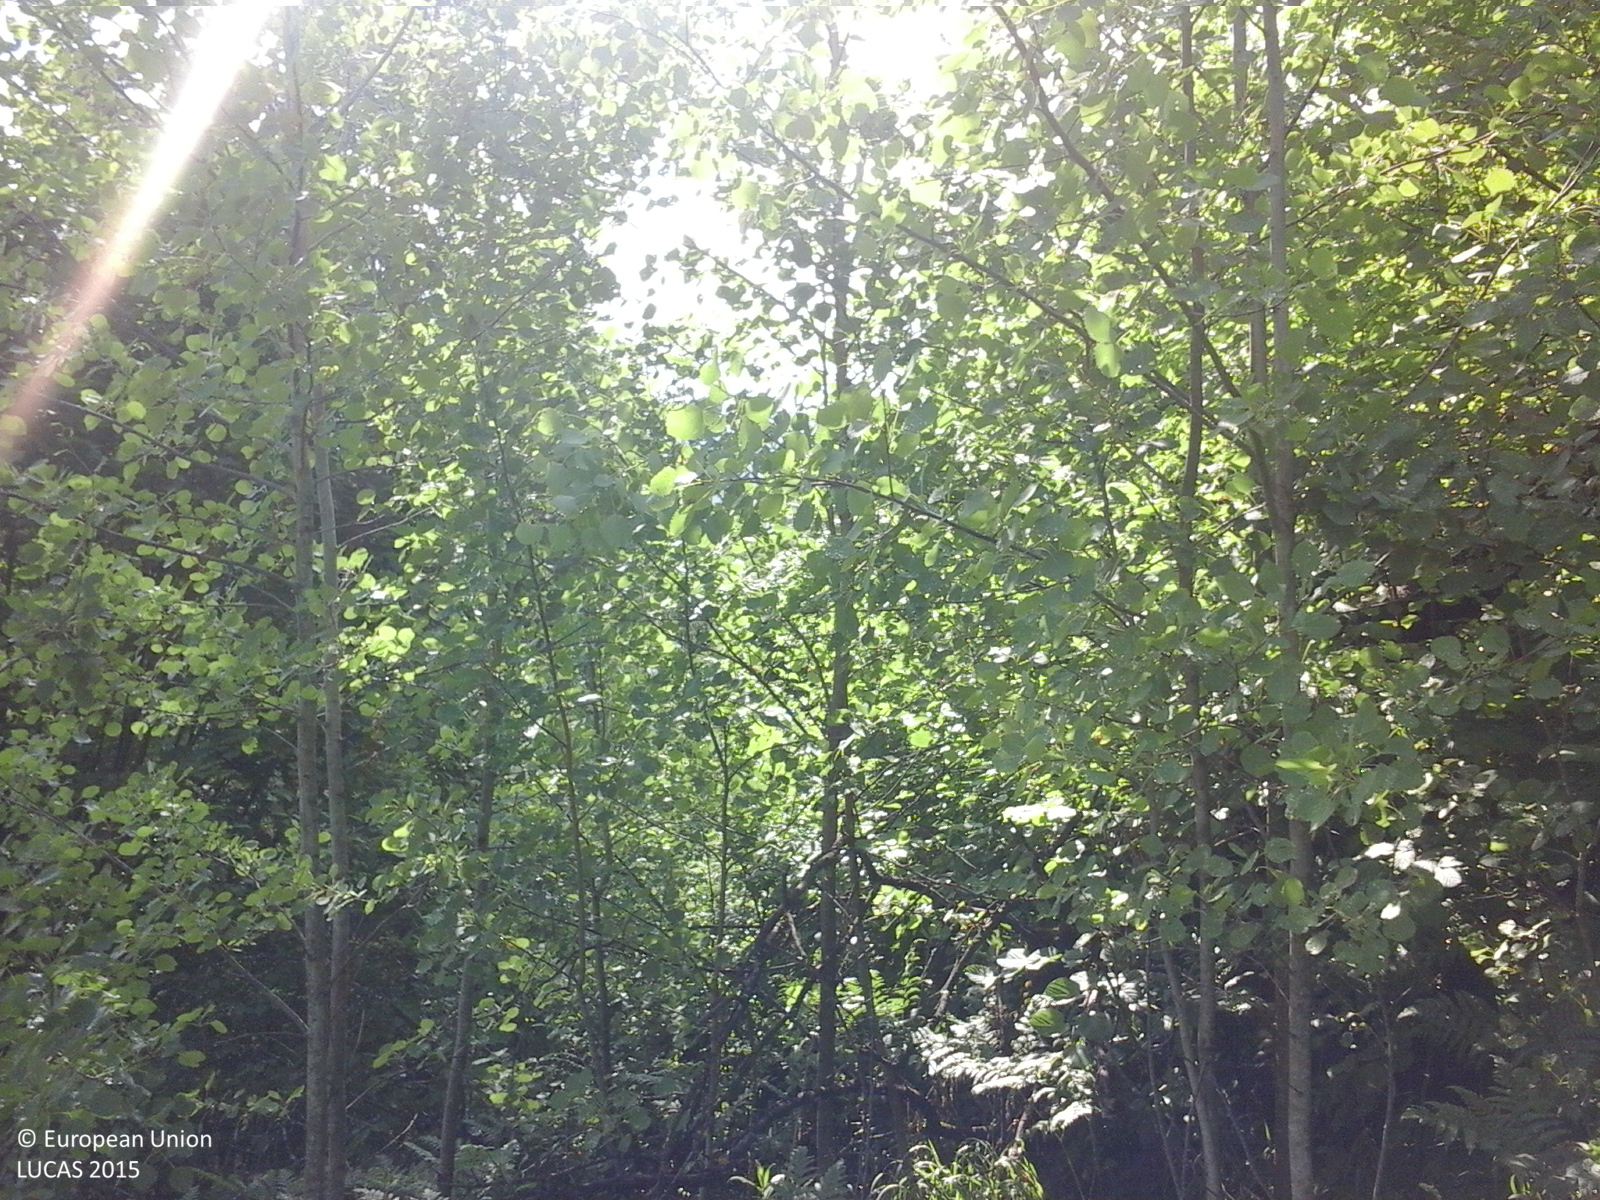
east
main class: Woodland
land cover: Spruce dominated coniferous woodland
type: alpine coniferous forest
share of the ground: > 75 %
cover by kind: coniferous forest trees 75 %, herbaceous plants 15 %, broadleaved forest trees 5 %, shrubs 5 %
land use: Forestry
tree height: > 5 m
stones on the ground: < 10 %
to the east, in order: Spruce dominated coniferous woodland; Electric lines; Fences; Spruce dominated coniferous woodland; Electric lines; Spruce dominated coniferous woodland; Ditches and canals; Grassland with sparse tree/shrub cover; Tracks; Grassland without tree/shrub cover; Ditches and canals; Fences; Grassland without tree/shrub cover; Spruce dominated coniferous woodland; Grassland without tree/shrub cover; Fences; Grassland without tree/shrub cover; Single bushes/trees; Grassland without tree/shrub cover
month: June
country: RO
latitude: 46.8678
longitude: 25.9573
